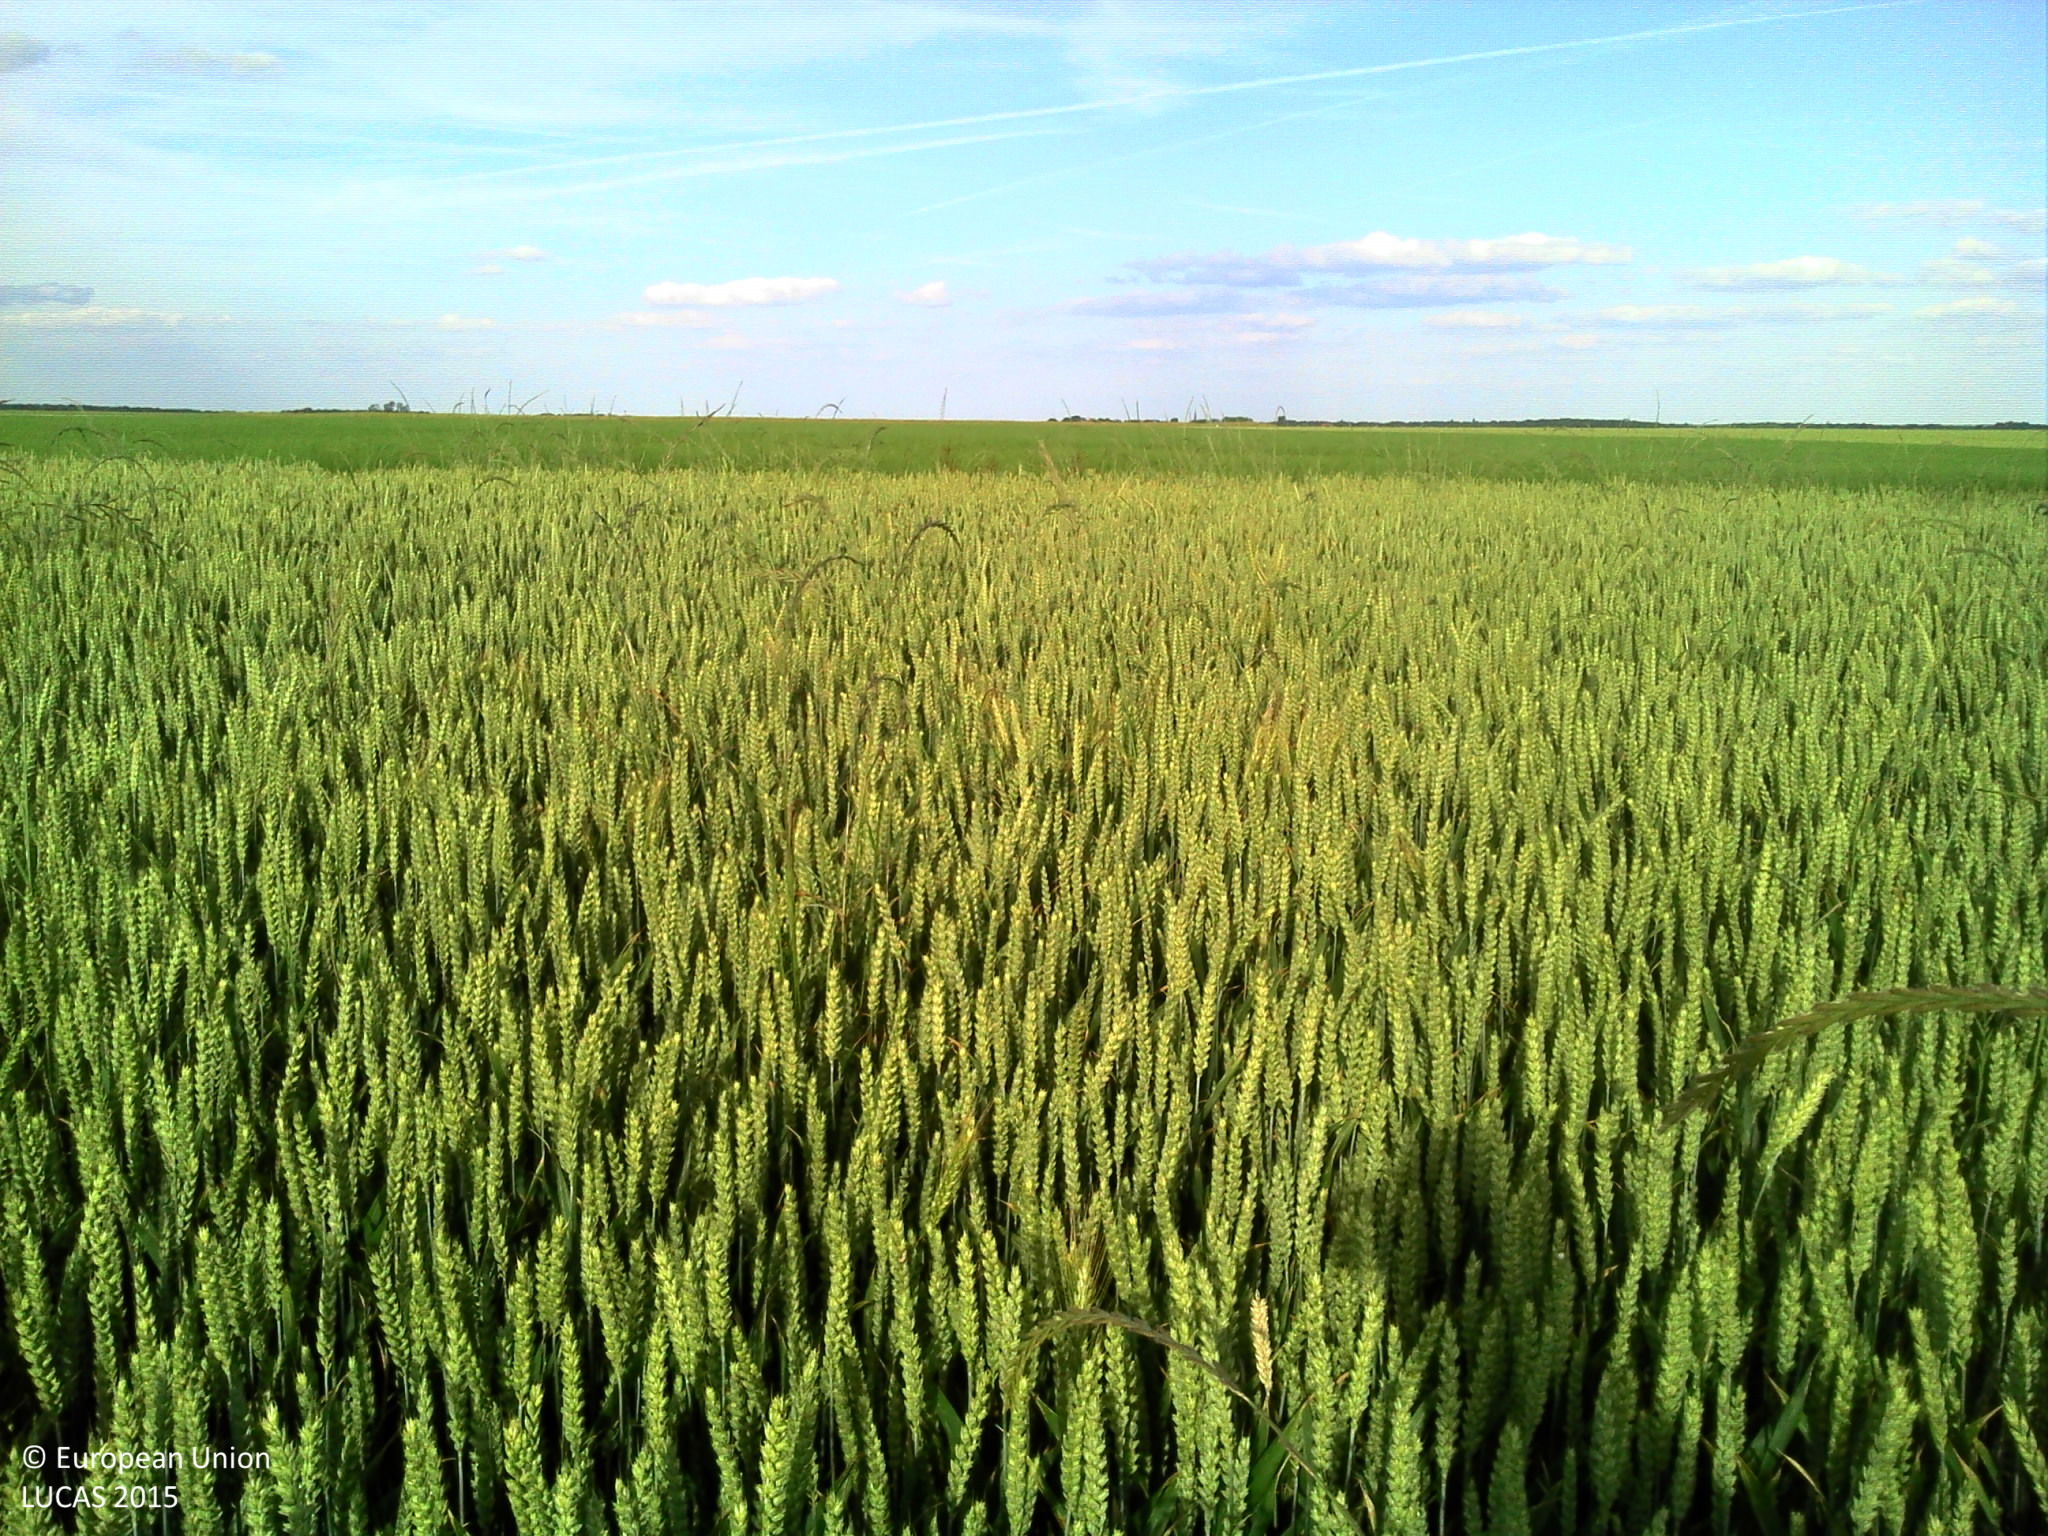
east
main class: Cropland
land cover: Common wheat
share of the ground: > 75 %
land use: Agriculture (excluding fallow land and kitchen gardens)
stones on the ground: < 10 %
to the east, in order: Common wheat; Tracks; Other fibre and oleaginous crops
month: June
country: FR
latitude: 49.2001
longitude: 1.0718
